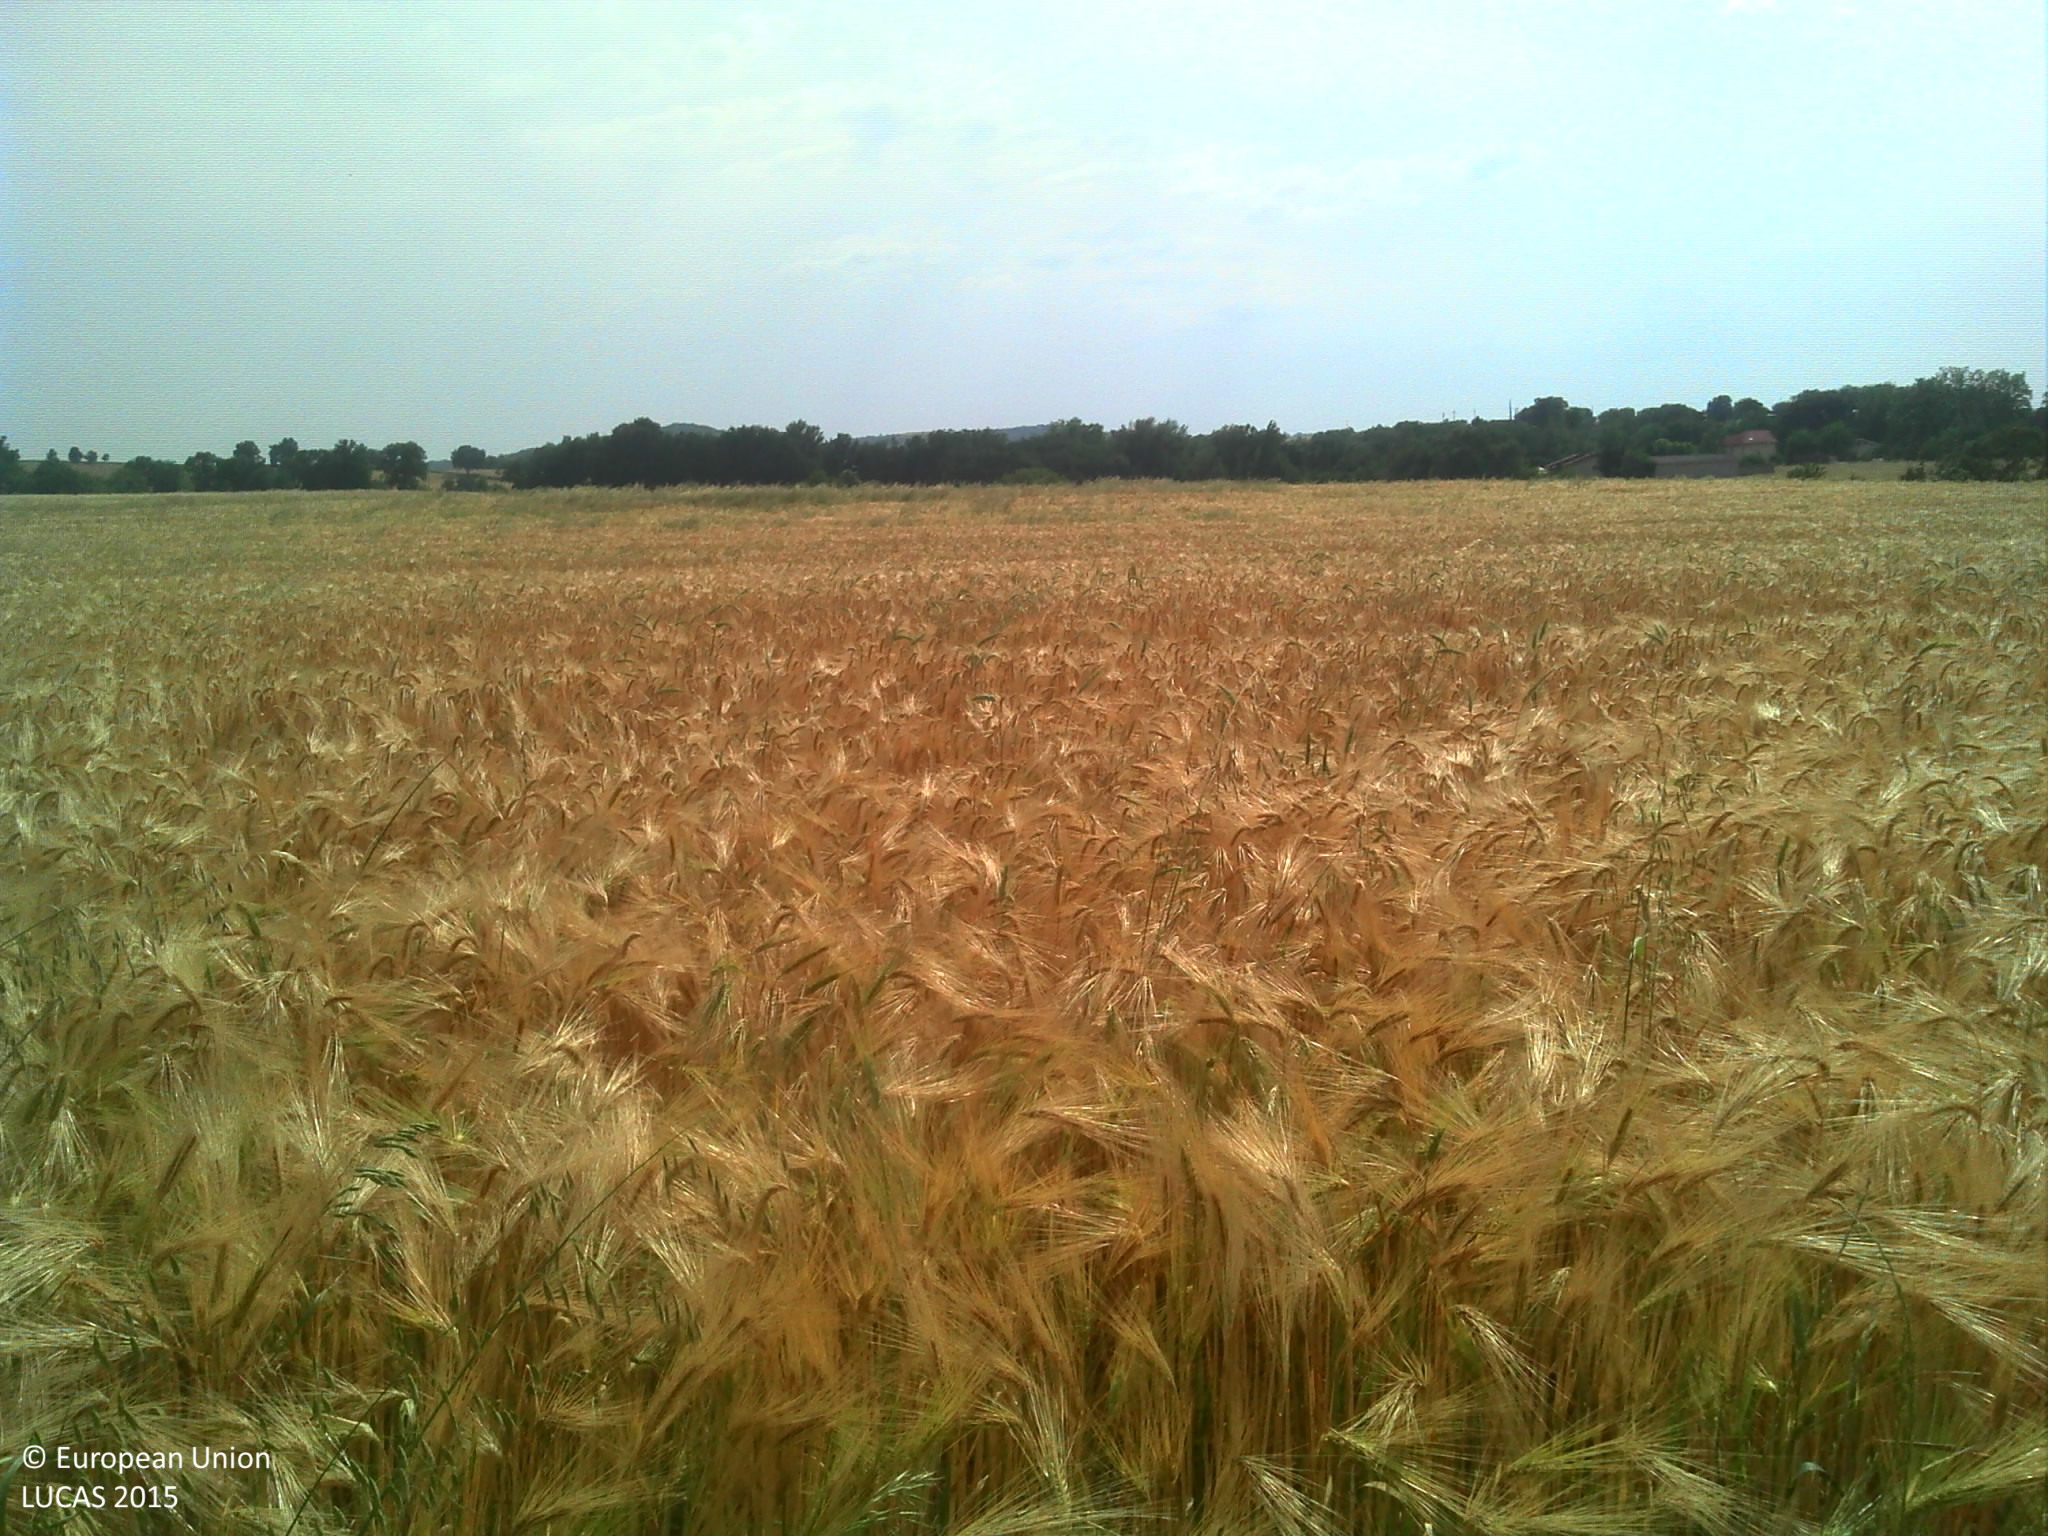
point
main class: Cropland
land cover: Barley
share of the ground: > 75 %
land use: Agriculture (excluding fallow land and kitchen gardens)
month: June
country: FR
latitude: 43.6415
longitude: 1.9841
